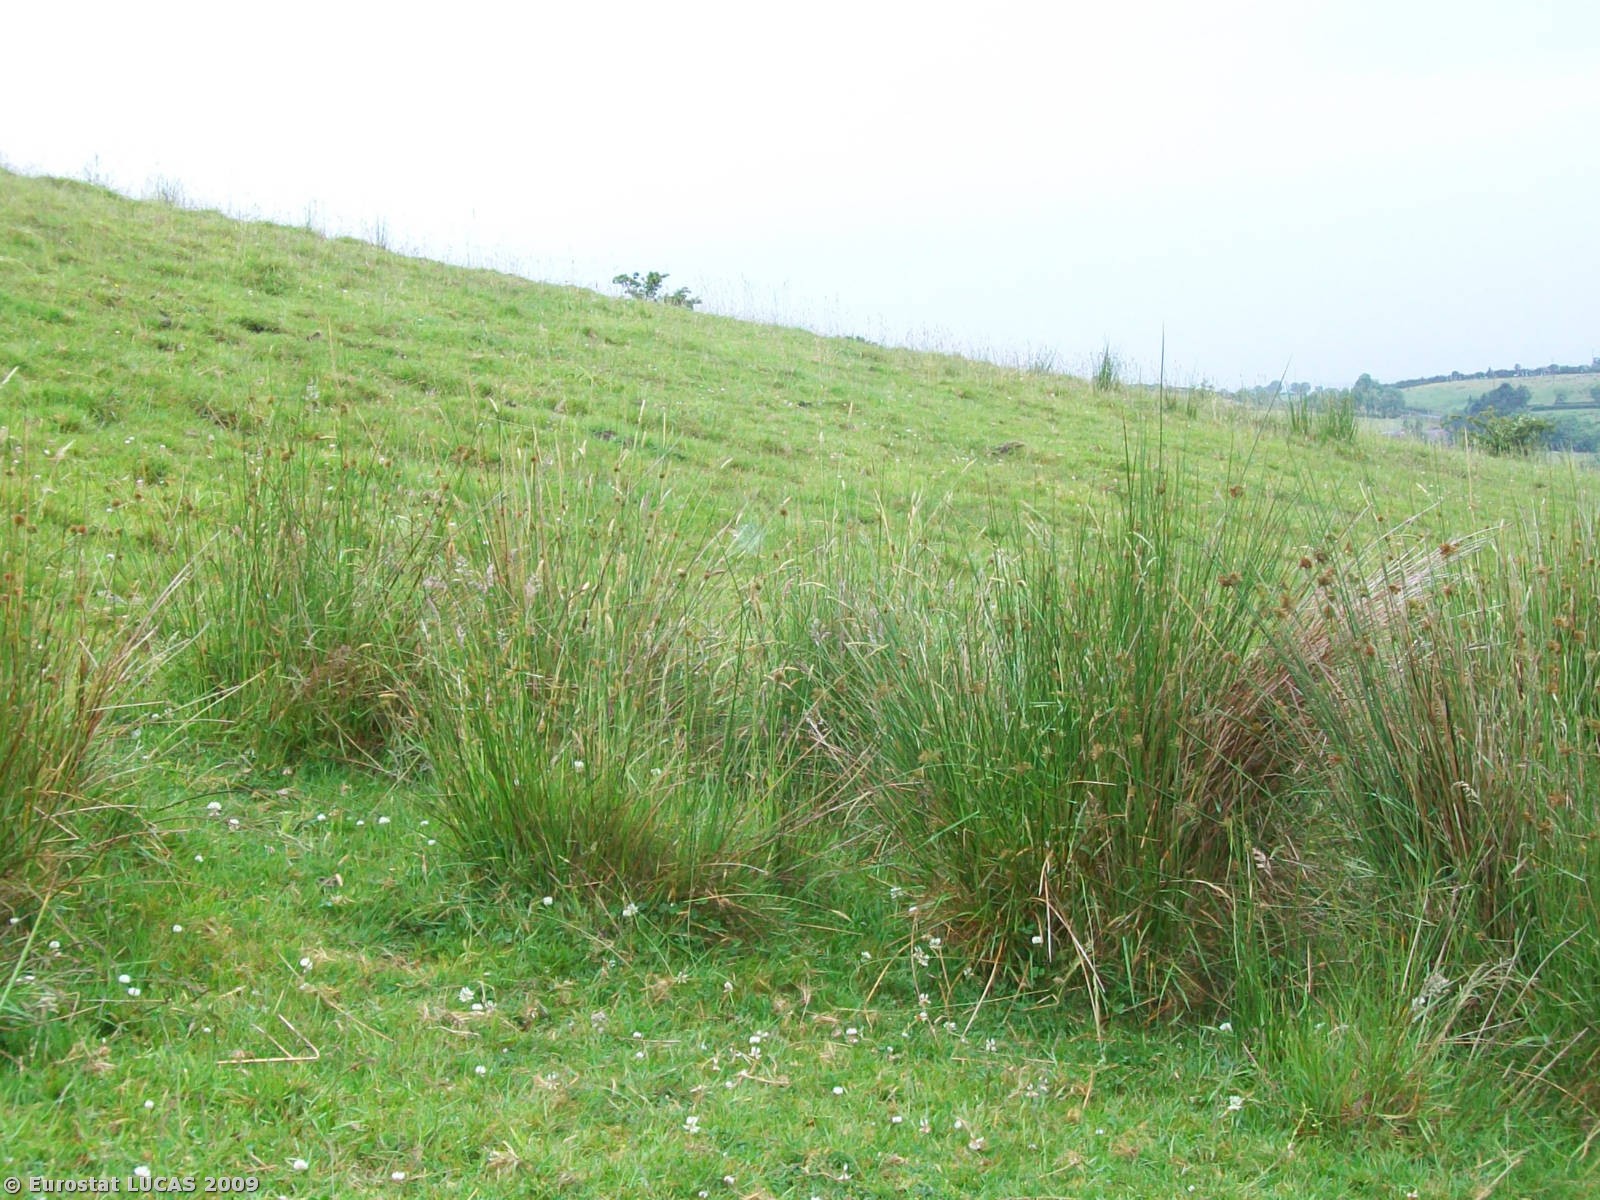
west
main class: Grassland
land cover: Grassland without tree/shrub cover
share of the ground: > 75 %
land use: Agriculture (excluding fallow land and kitchen gardens)
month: June
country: GB
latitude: 54.4526
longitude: -7.3800
